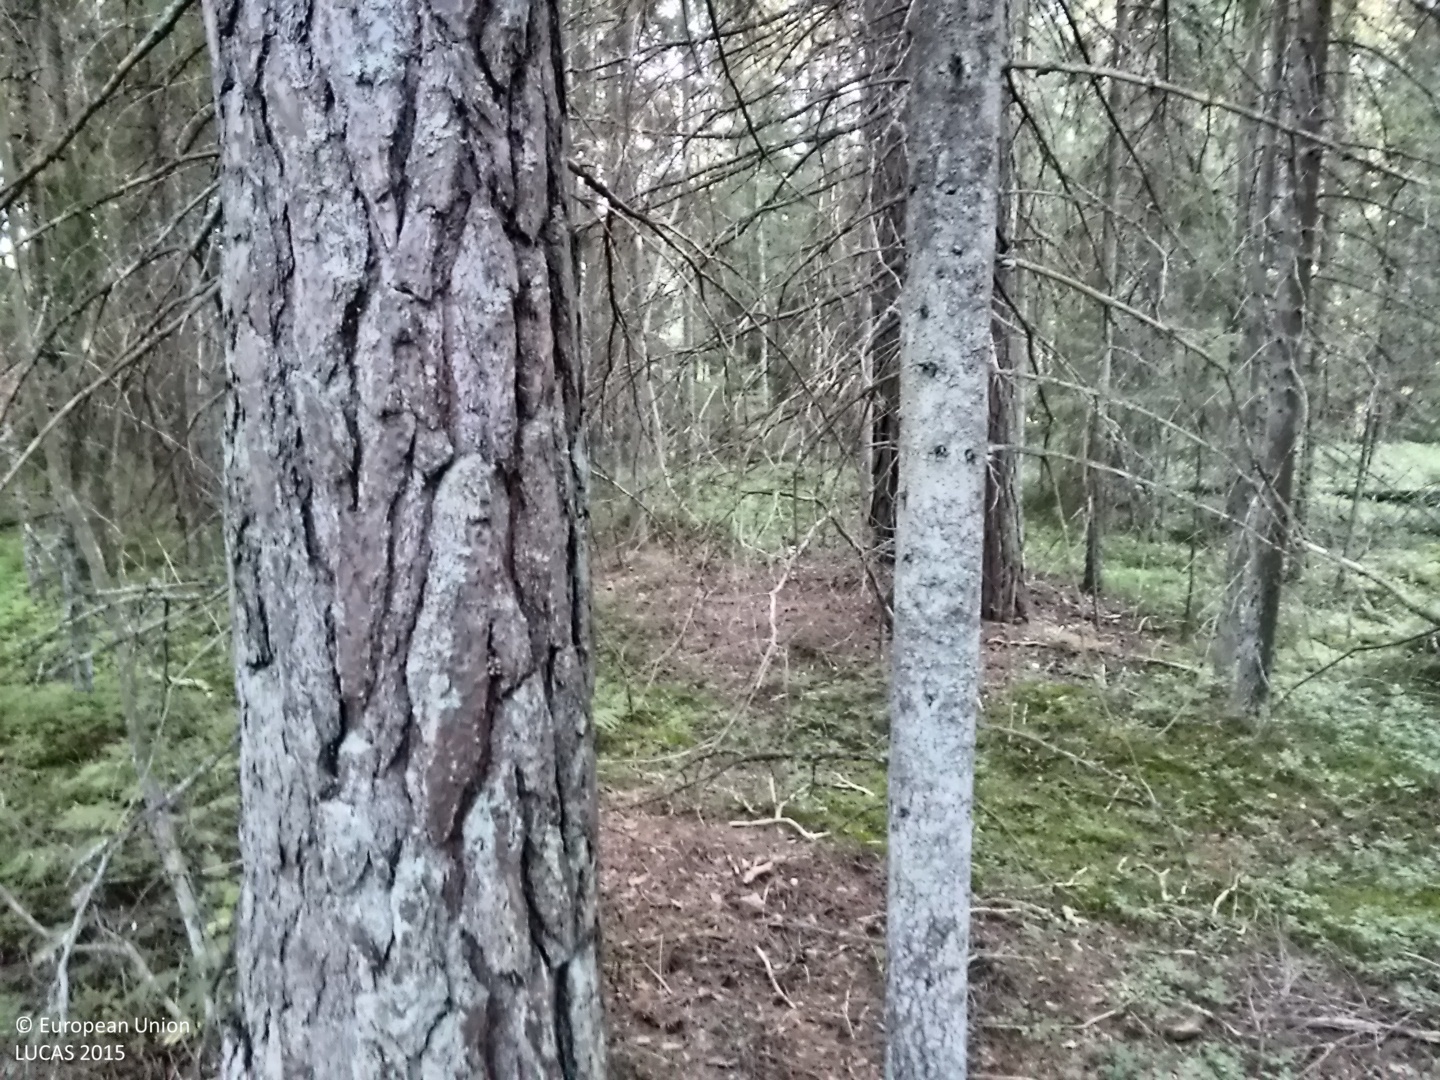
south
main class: Woodland
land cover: Pine dominated coniferous woodland
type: hemiboreal forest and nemoral coniferous forest and mixed broadleaved-coniferous forest
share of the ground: > 75 %
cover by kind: coniferous forest trees 85 %, shrubs 5 %, herbaceous plants 5 %, lichens and mosses 5 %
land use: Forestry
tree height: > 5 m
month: August
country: FI
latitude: 60.2631
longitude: 19.9648
